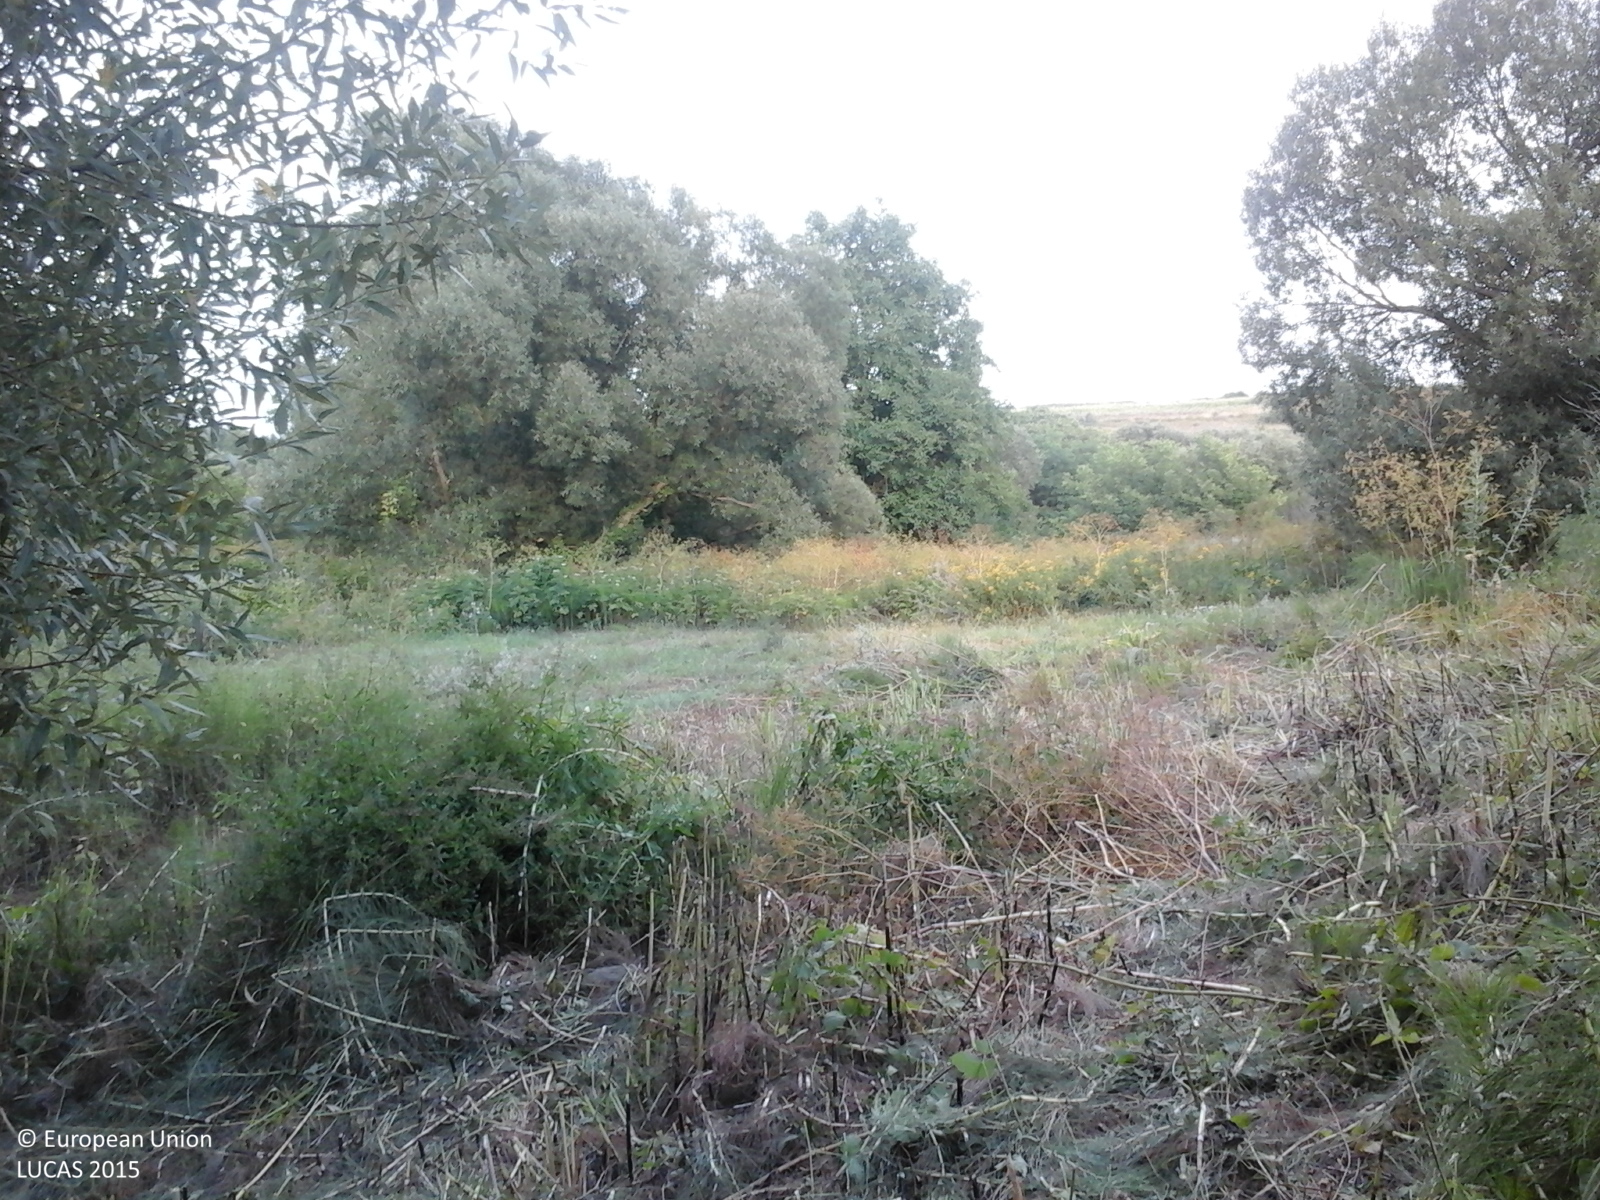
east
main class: Shrubland
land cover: Shrubland with sparse tree cover
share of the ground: > 75 %
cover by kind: shrubs 85 %, herbaceous plants 10 %, broadleaved forest trees 5 %
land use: Fallow land
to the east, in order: Shrubland with sparse tree cover; Inland marshes; Rivers and streams; Inland marshes; Broadleaved woodland; Spontaneously vegetated surfaces; Ditches and canals; Broadleaved woodland
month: July
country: RO
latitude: 46.2194
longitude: 26.8251
